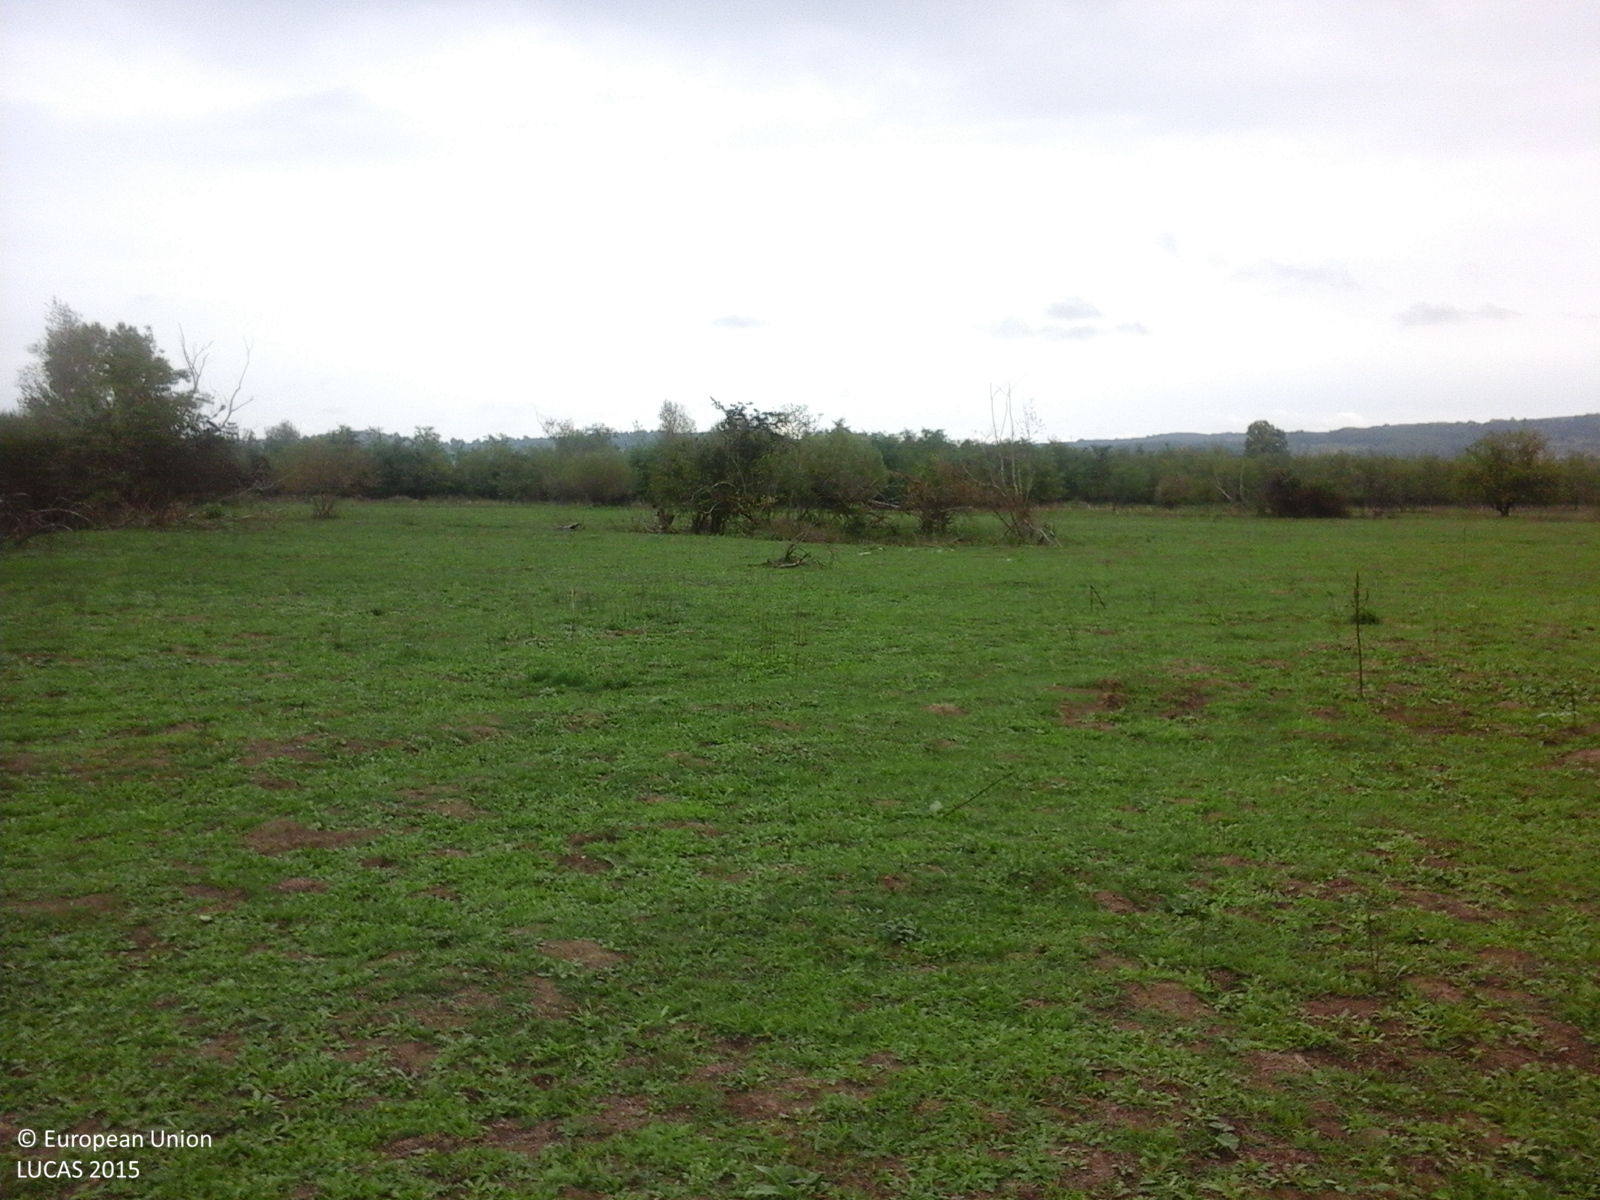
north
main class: Grassland
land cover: Grassland without tree/shrub cover
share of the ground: > 75 %
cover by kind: herbaceous plants 100 %
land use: Agriculture (excluding fallow land and kitchen gardens)
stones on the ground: < 10 %
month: September
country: RO
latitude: 45.6326
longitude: 22.0338
